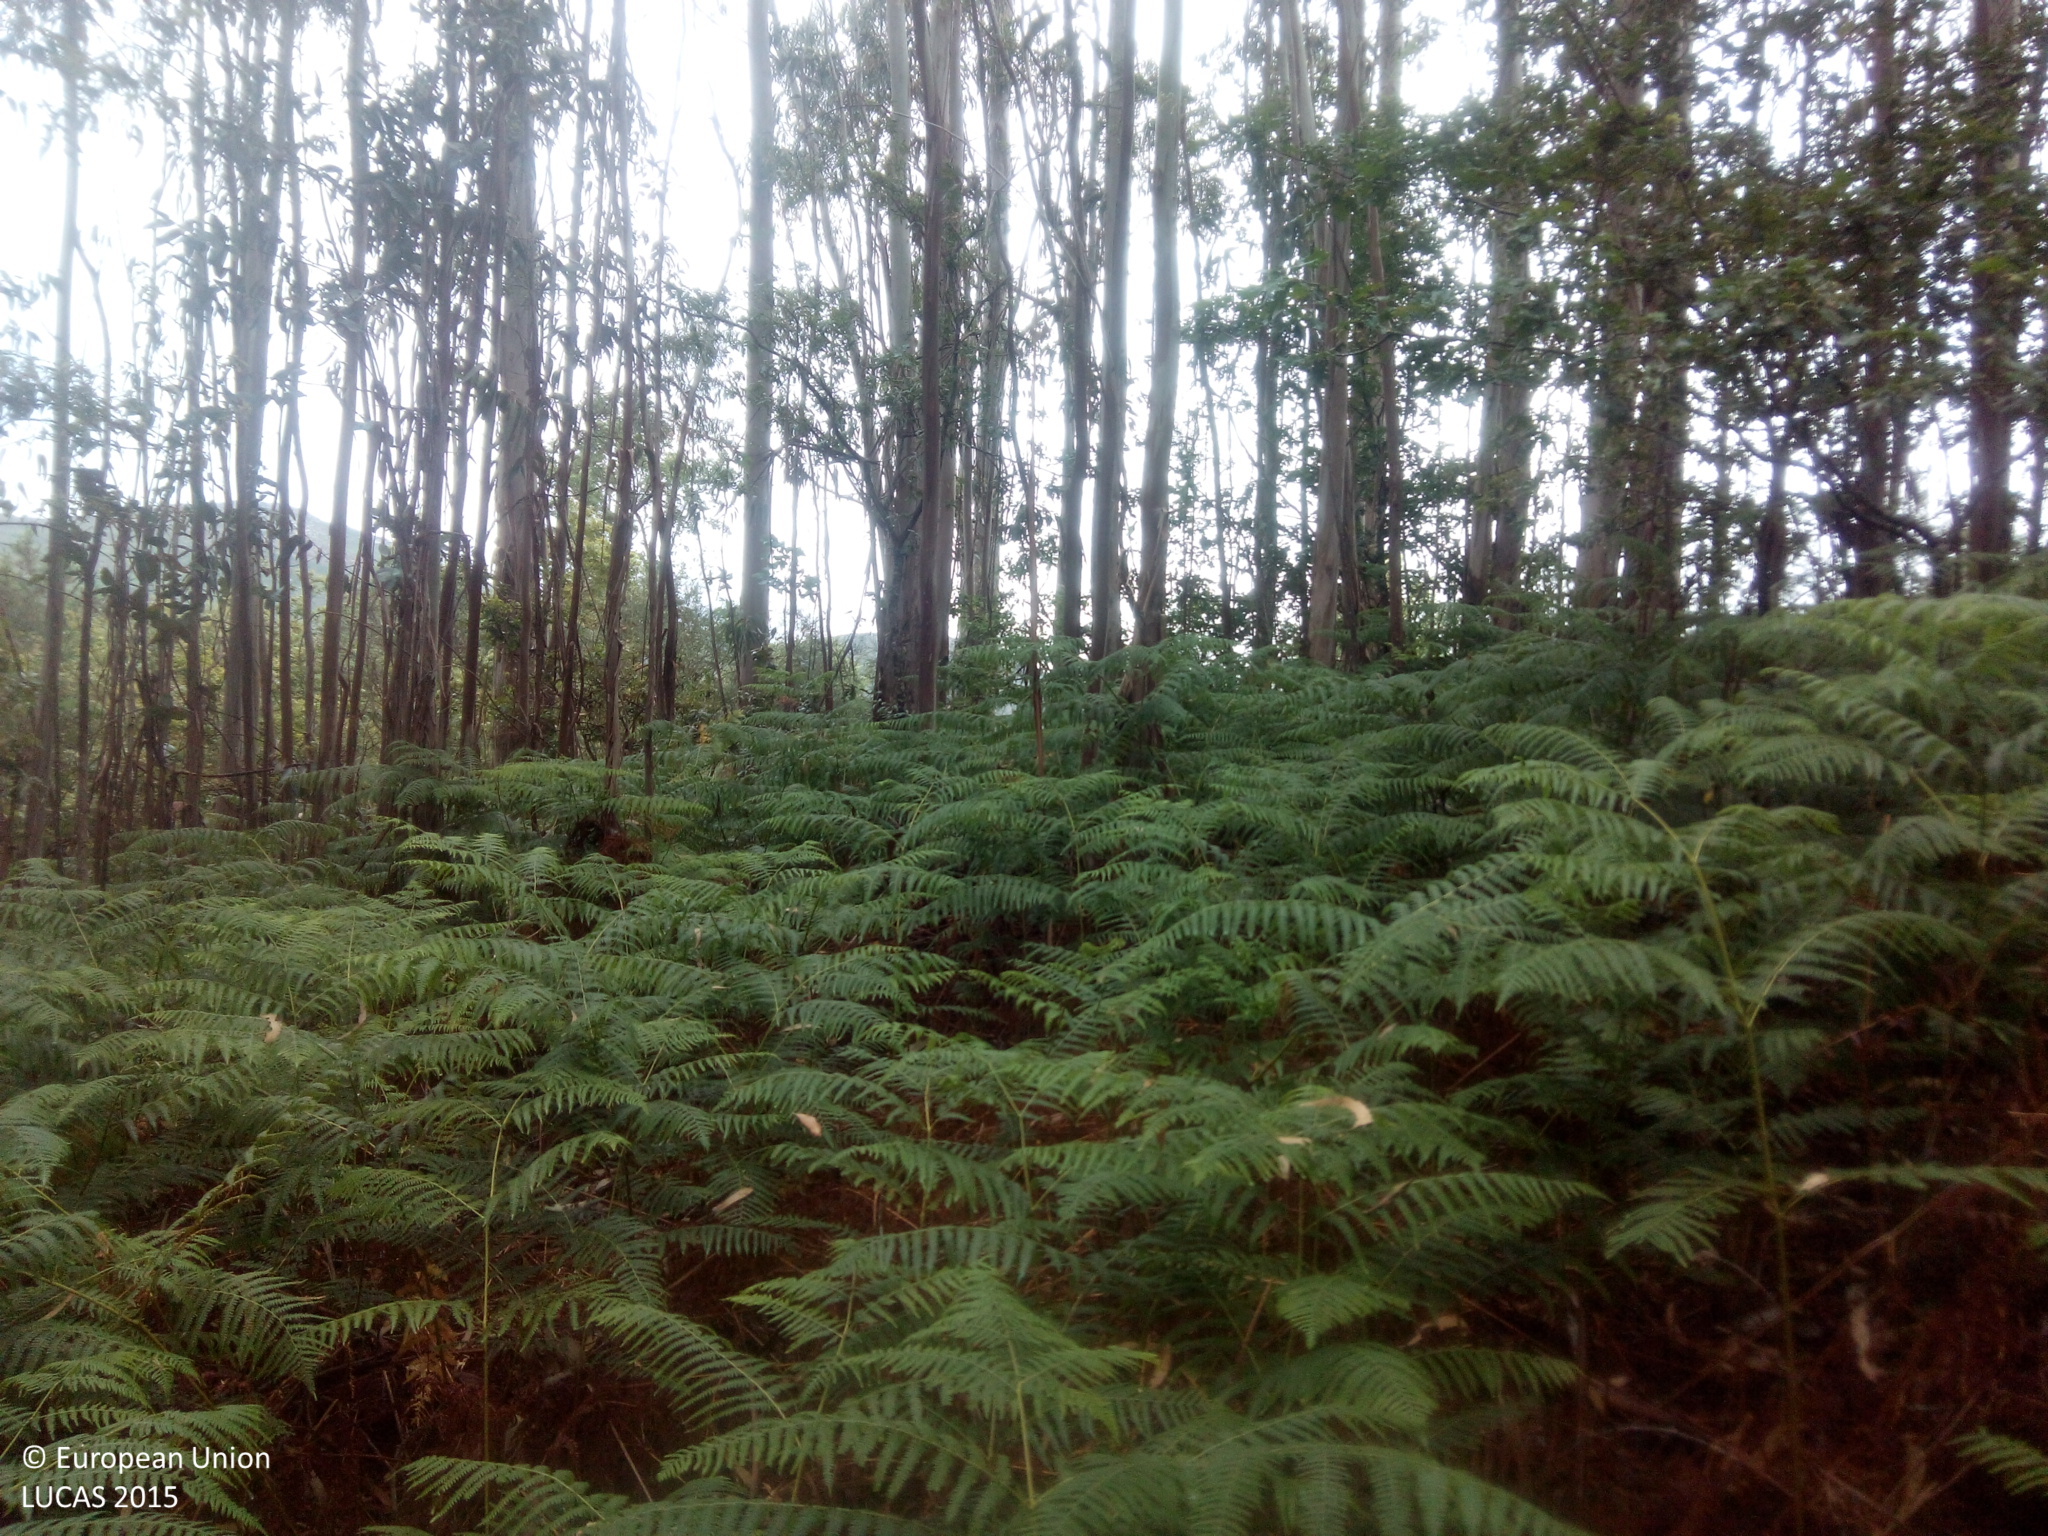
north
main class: Woodland
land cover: Broadleaved woodland
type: exotic forest
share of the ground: > 75 %
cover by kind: broadleaved forest trees 100 %
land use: Forestry
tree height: > 5 m
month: July
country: ES
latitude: 42.2742
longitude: -8.3382
